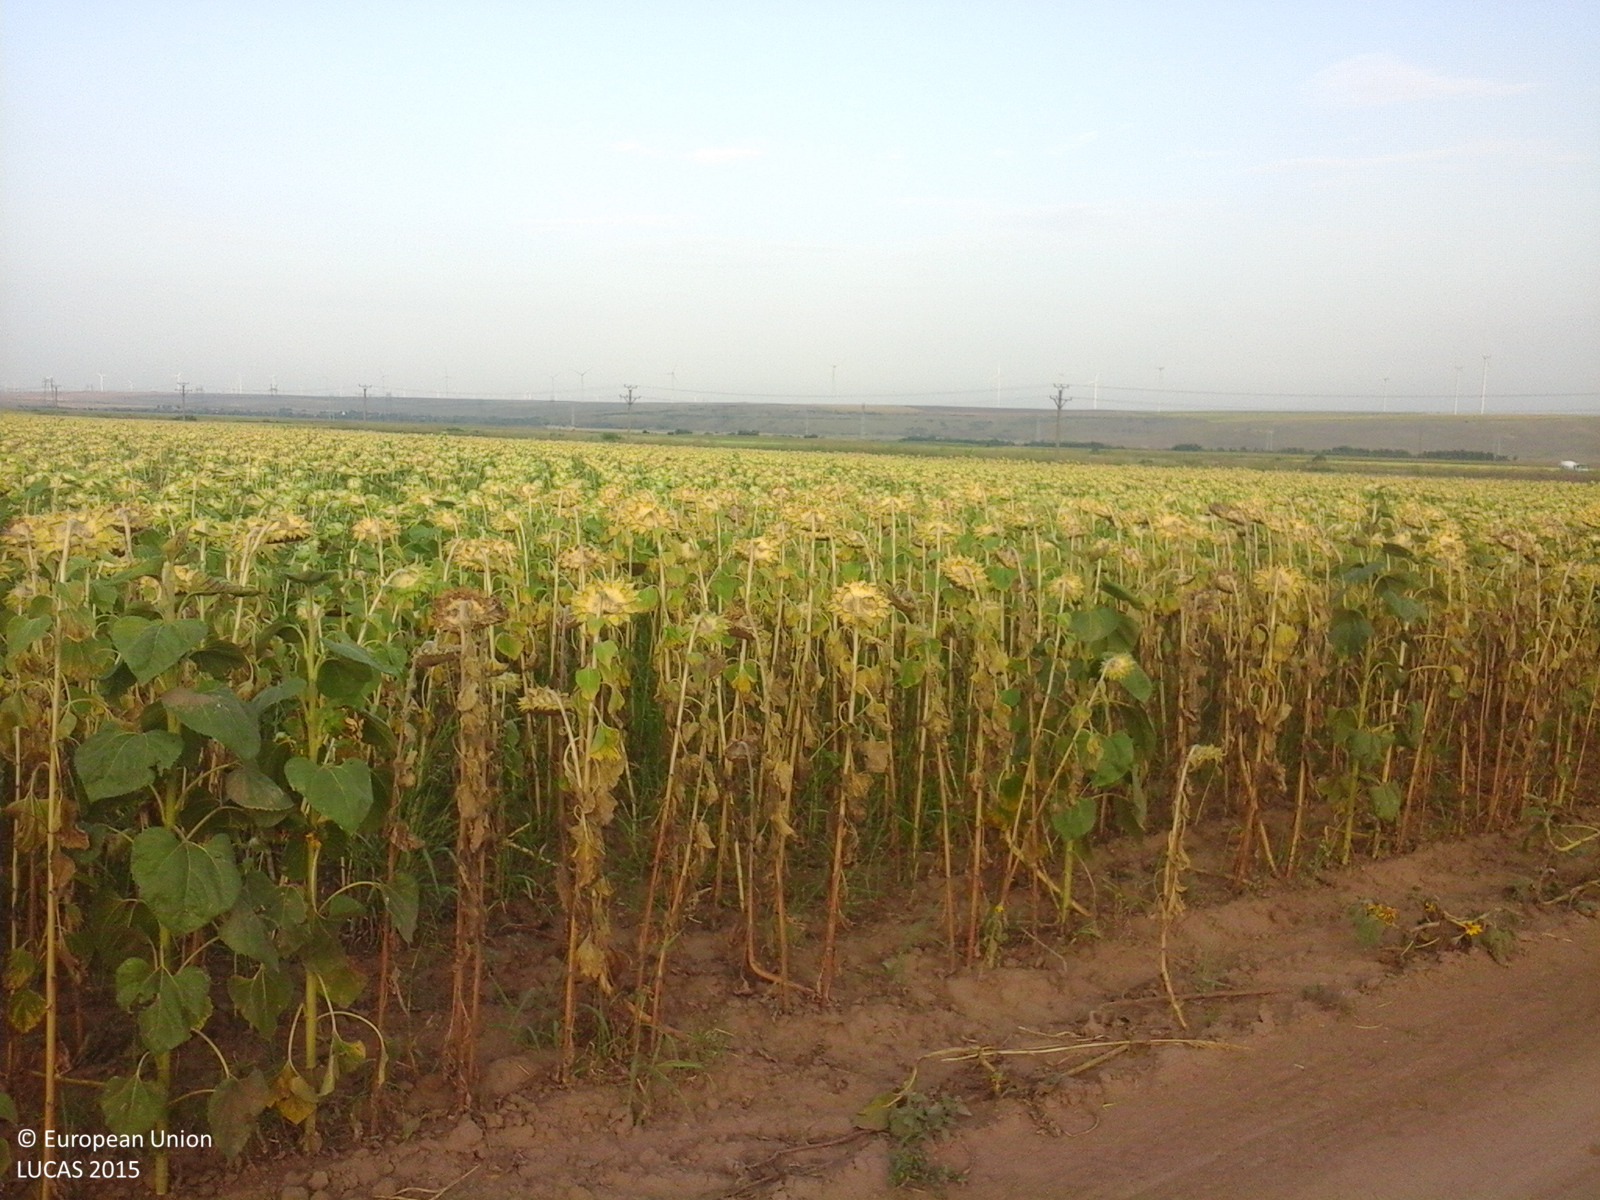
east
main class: Cropland
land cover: Sunflower
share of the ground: > 75 %
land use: Agriculture (excluding fallow land and kitchen gardens)
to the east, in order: Sunflower; Tracks; Sunflower
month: August
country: RO
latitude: 44.3981
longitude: 28.1270
